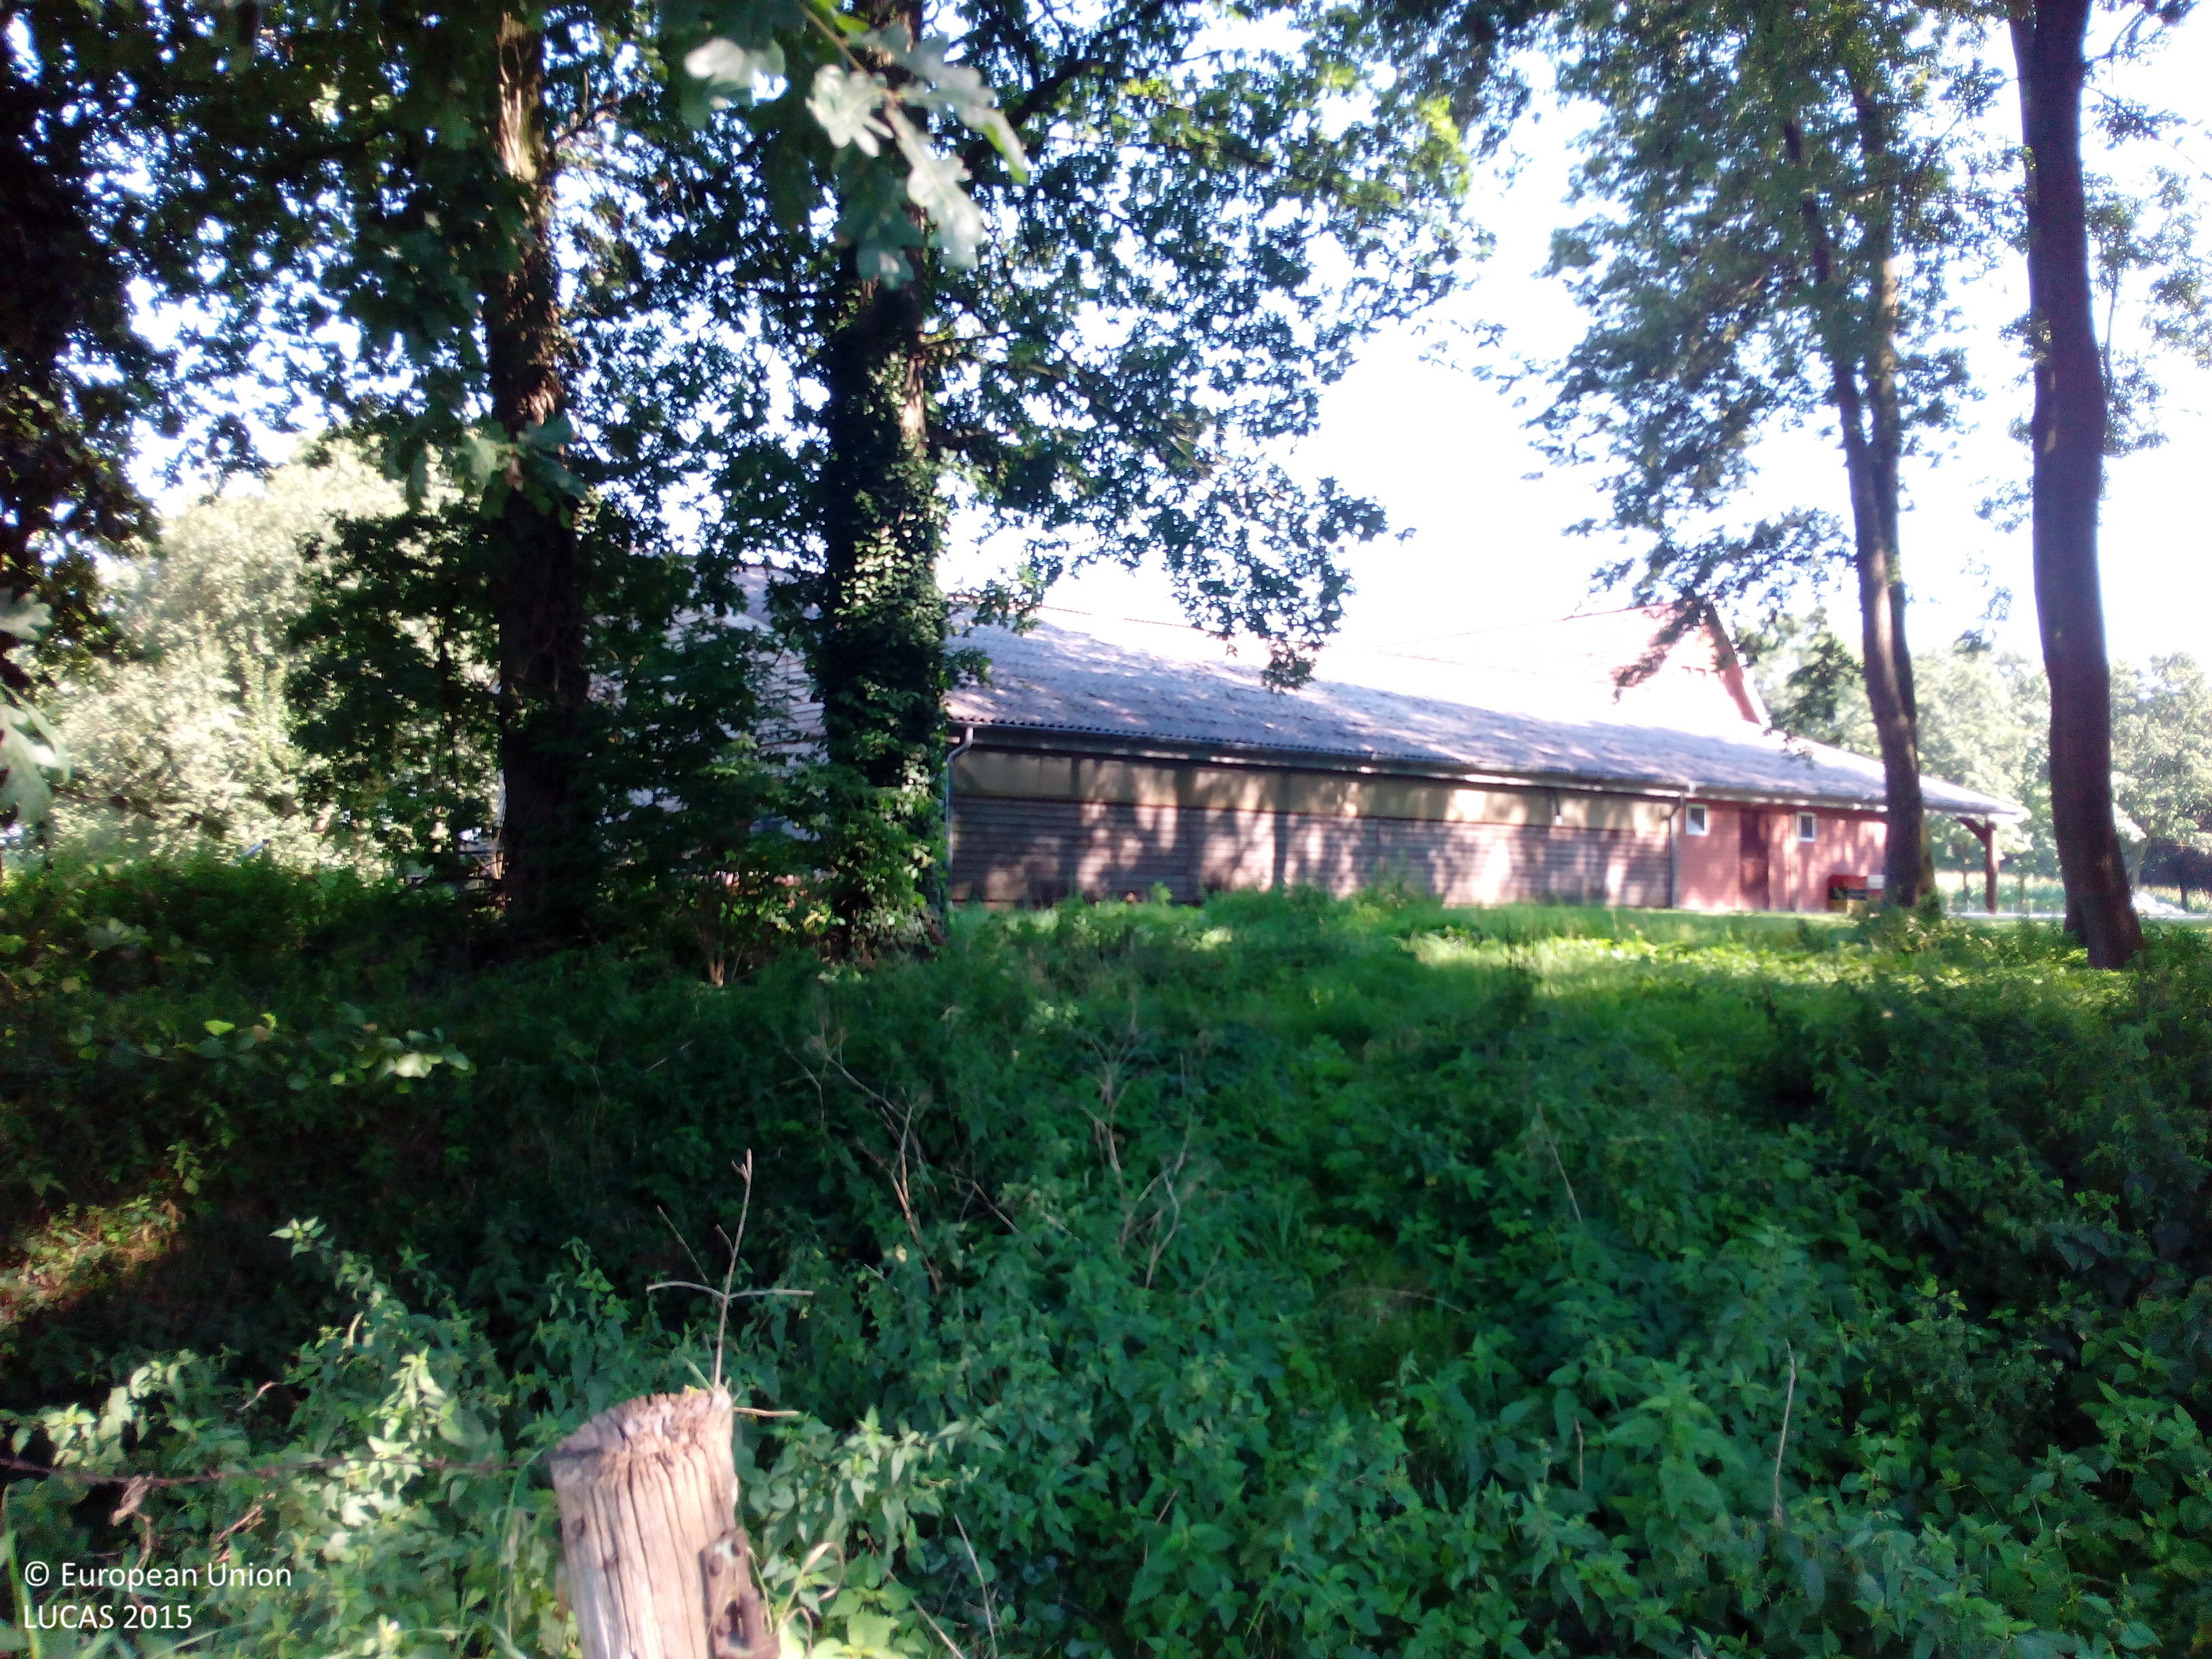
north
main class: Cropland
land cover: Maize
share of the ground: > 75 %
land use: Agriculture (excluding fallow land and kitchen gardens)
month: August
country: DE
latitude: 52.7023
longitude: 8.0027
